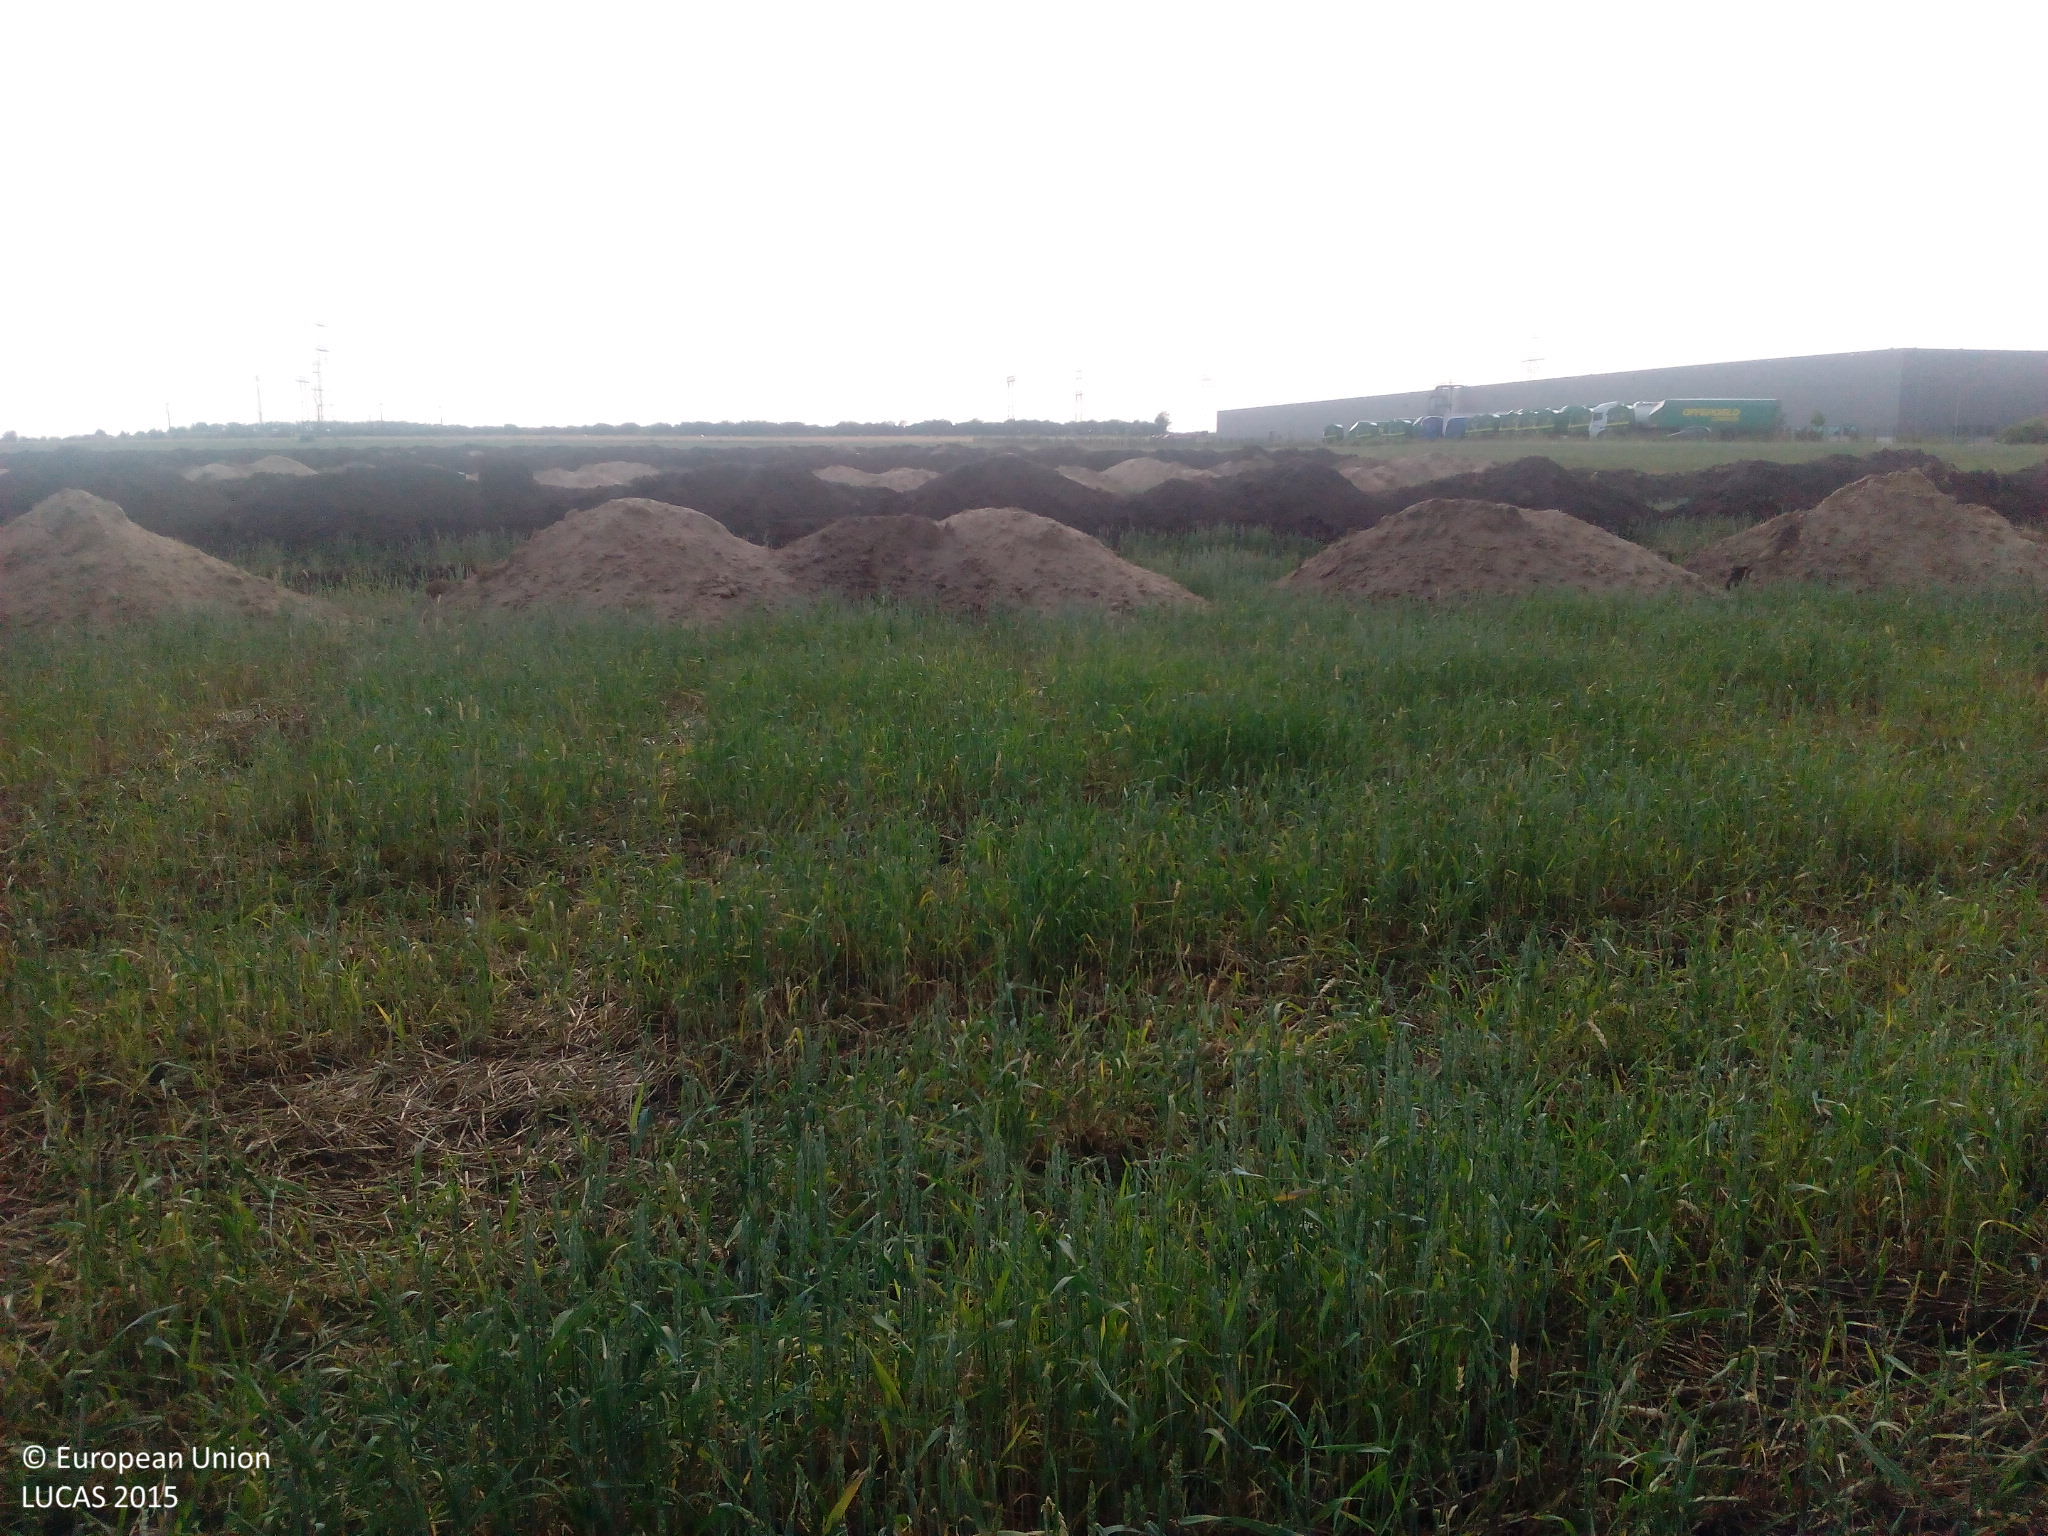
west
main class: Cropland
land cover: Common wheat
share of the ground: 25 - 50 %
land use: Agriculture (excluding fallow land and kitchen gardens)
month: July
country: DE
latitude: 52.0616
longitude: 11.5603
